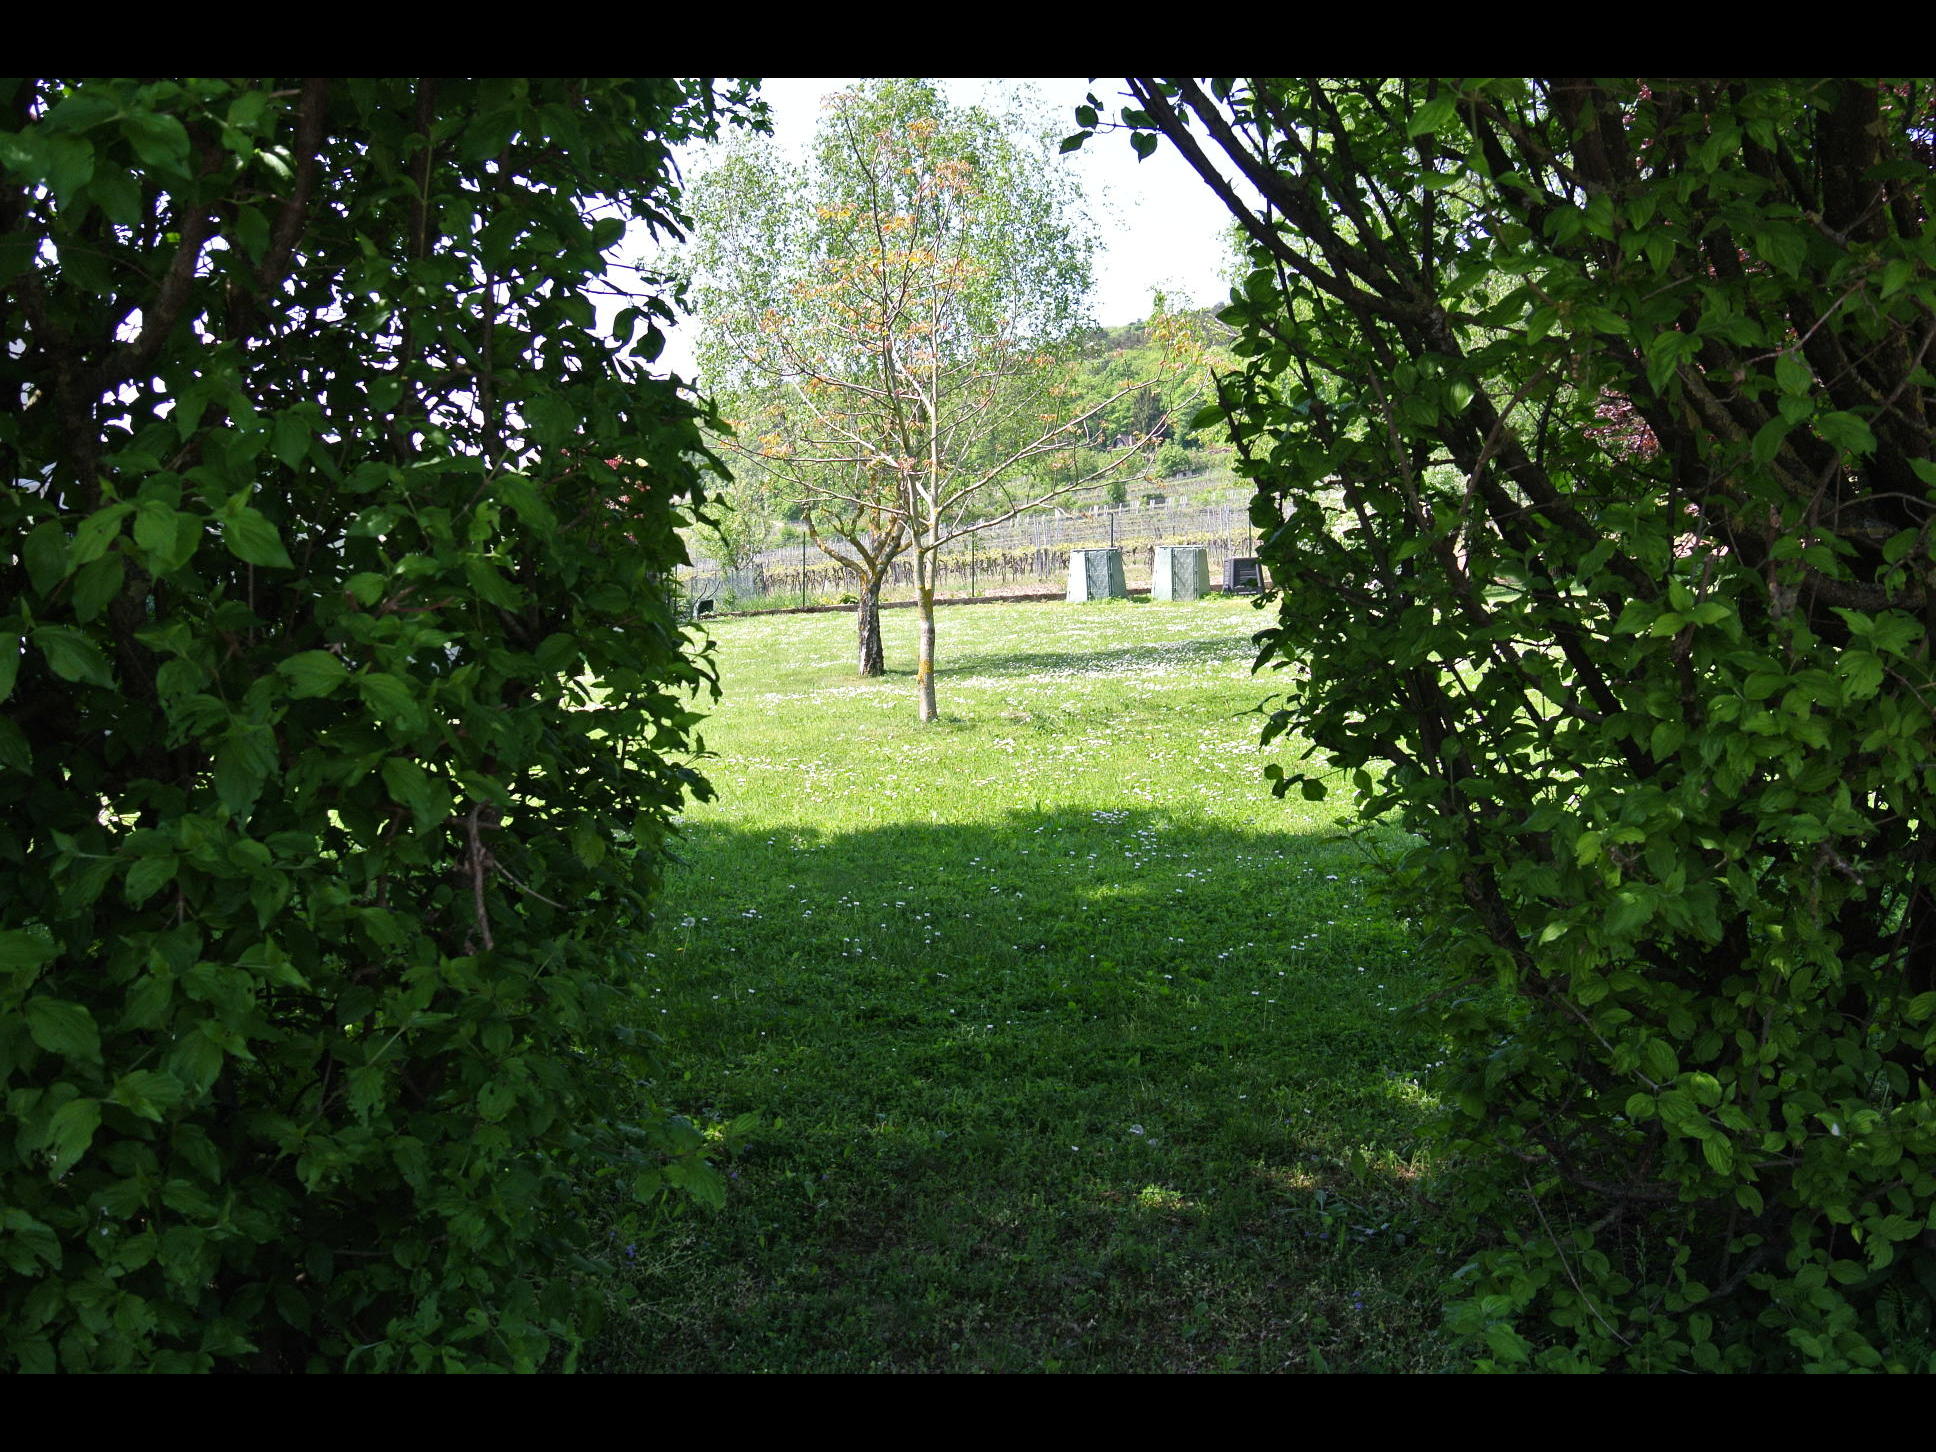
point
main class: Grassland
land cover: Grassland with sparse tree/shrub cover
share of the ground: > 75 %
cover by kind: herbaceous plants 85 %, shrubs 10 %, broadleaved forest trees 5 %
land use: Residential
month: May
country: AT
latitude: 48.1183
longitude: 16.2508
